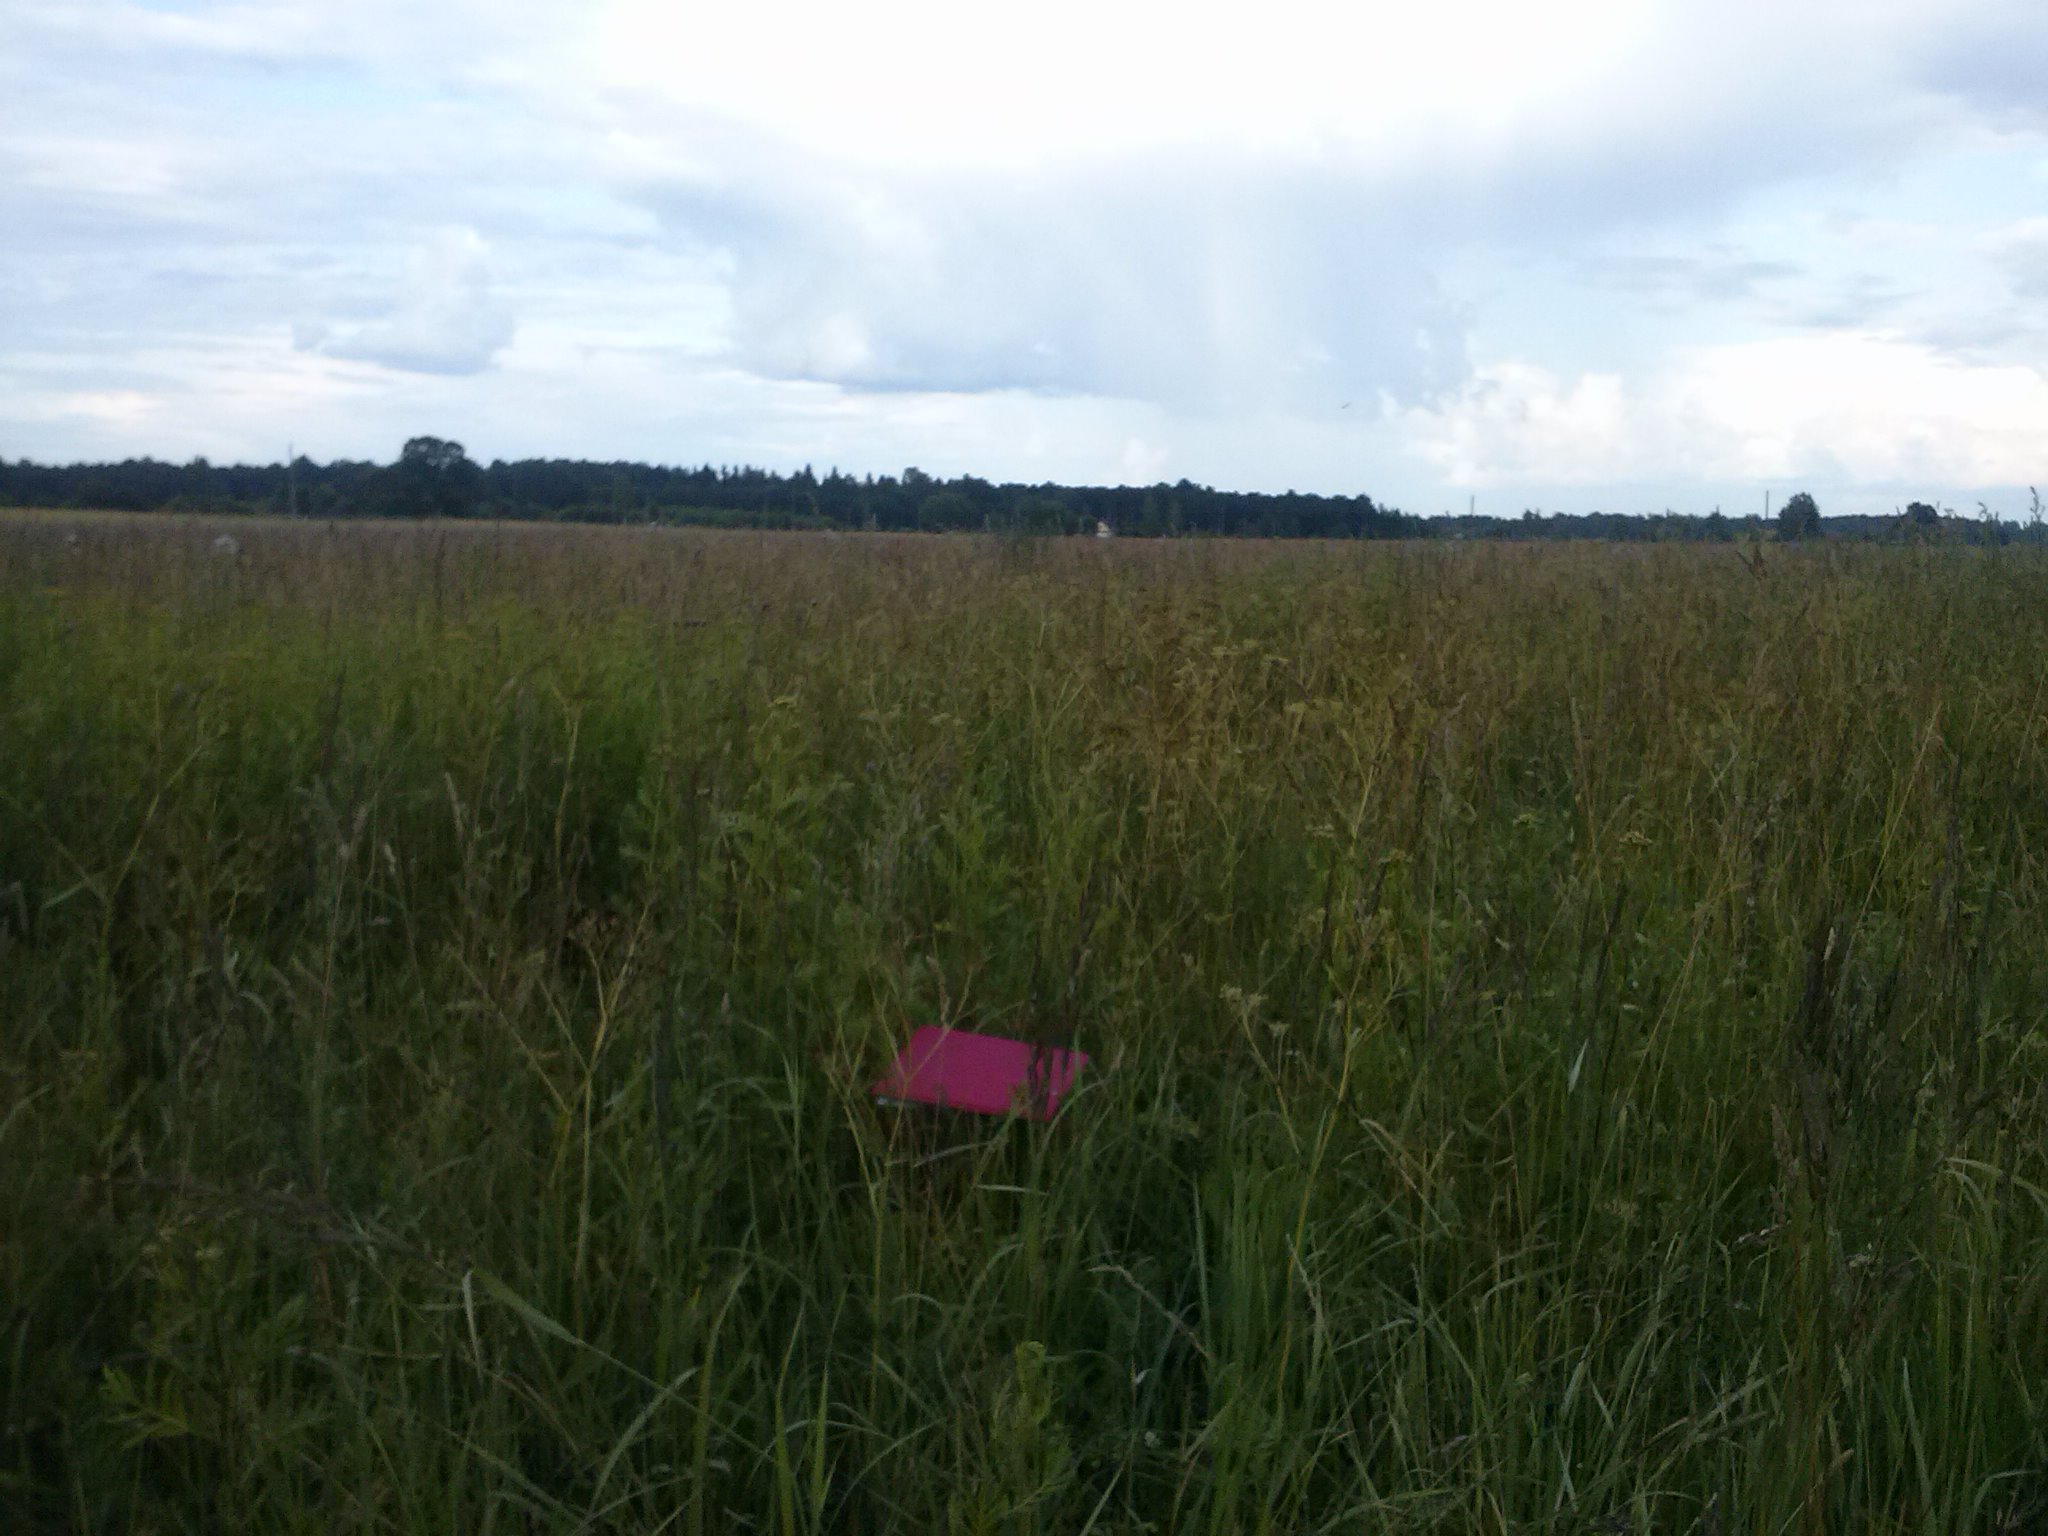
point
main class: Grassland
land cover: Grassland without tree/shrub cover
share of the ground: > 75 %
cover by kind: herbaceous plants 100 %
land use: Agriculture (excluding fallow land and kitchen gardens)
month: July
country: LV
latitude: 56.7735
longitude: 27.8118
